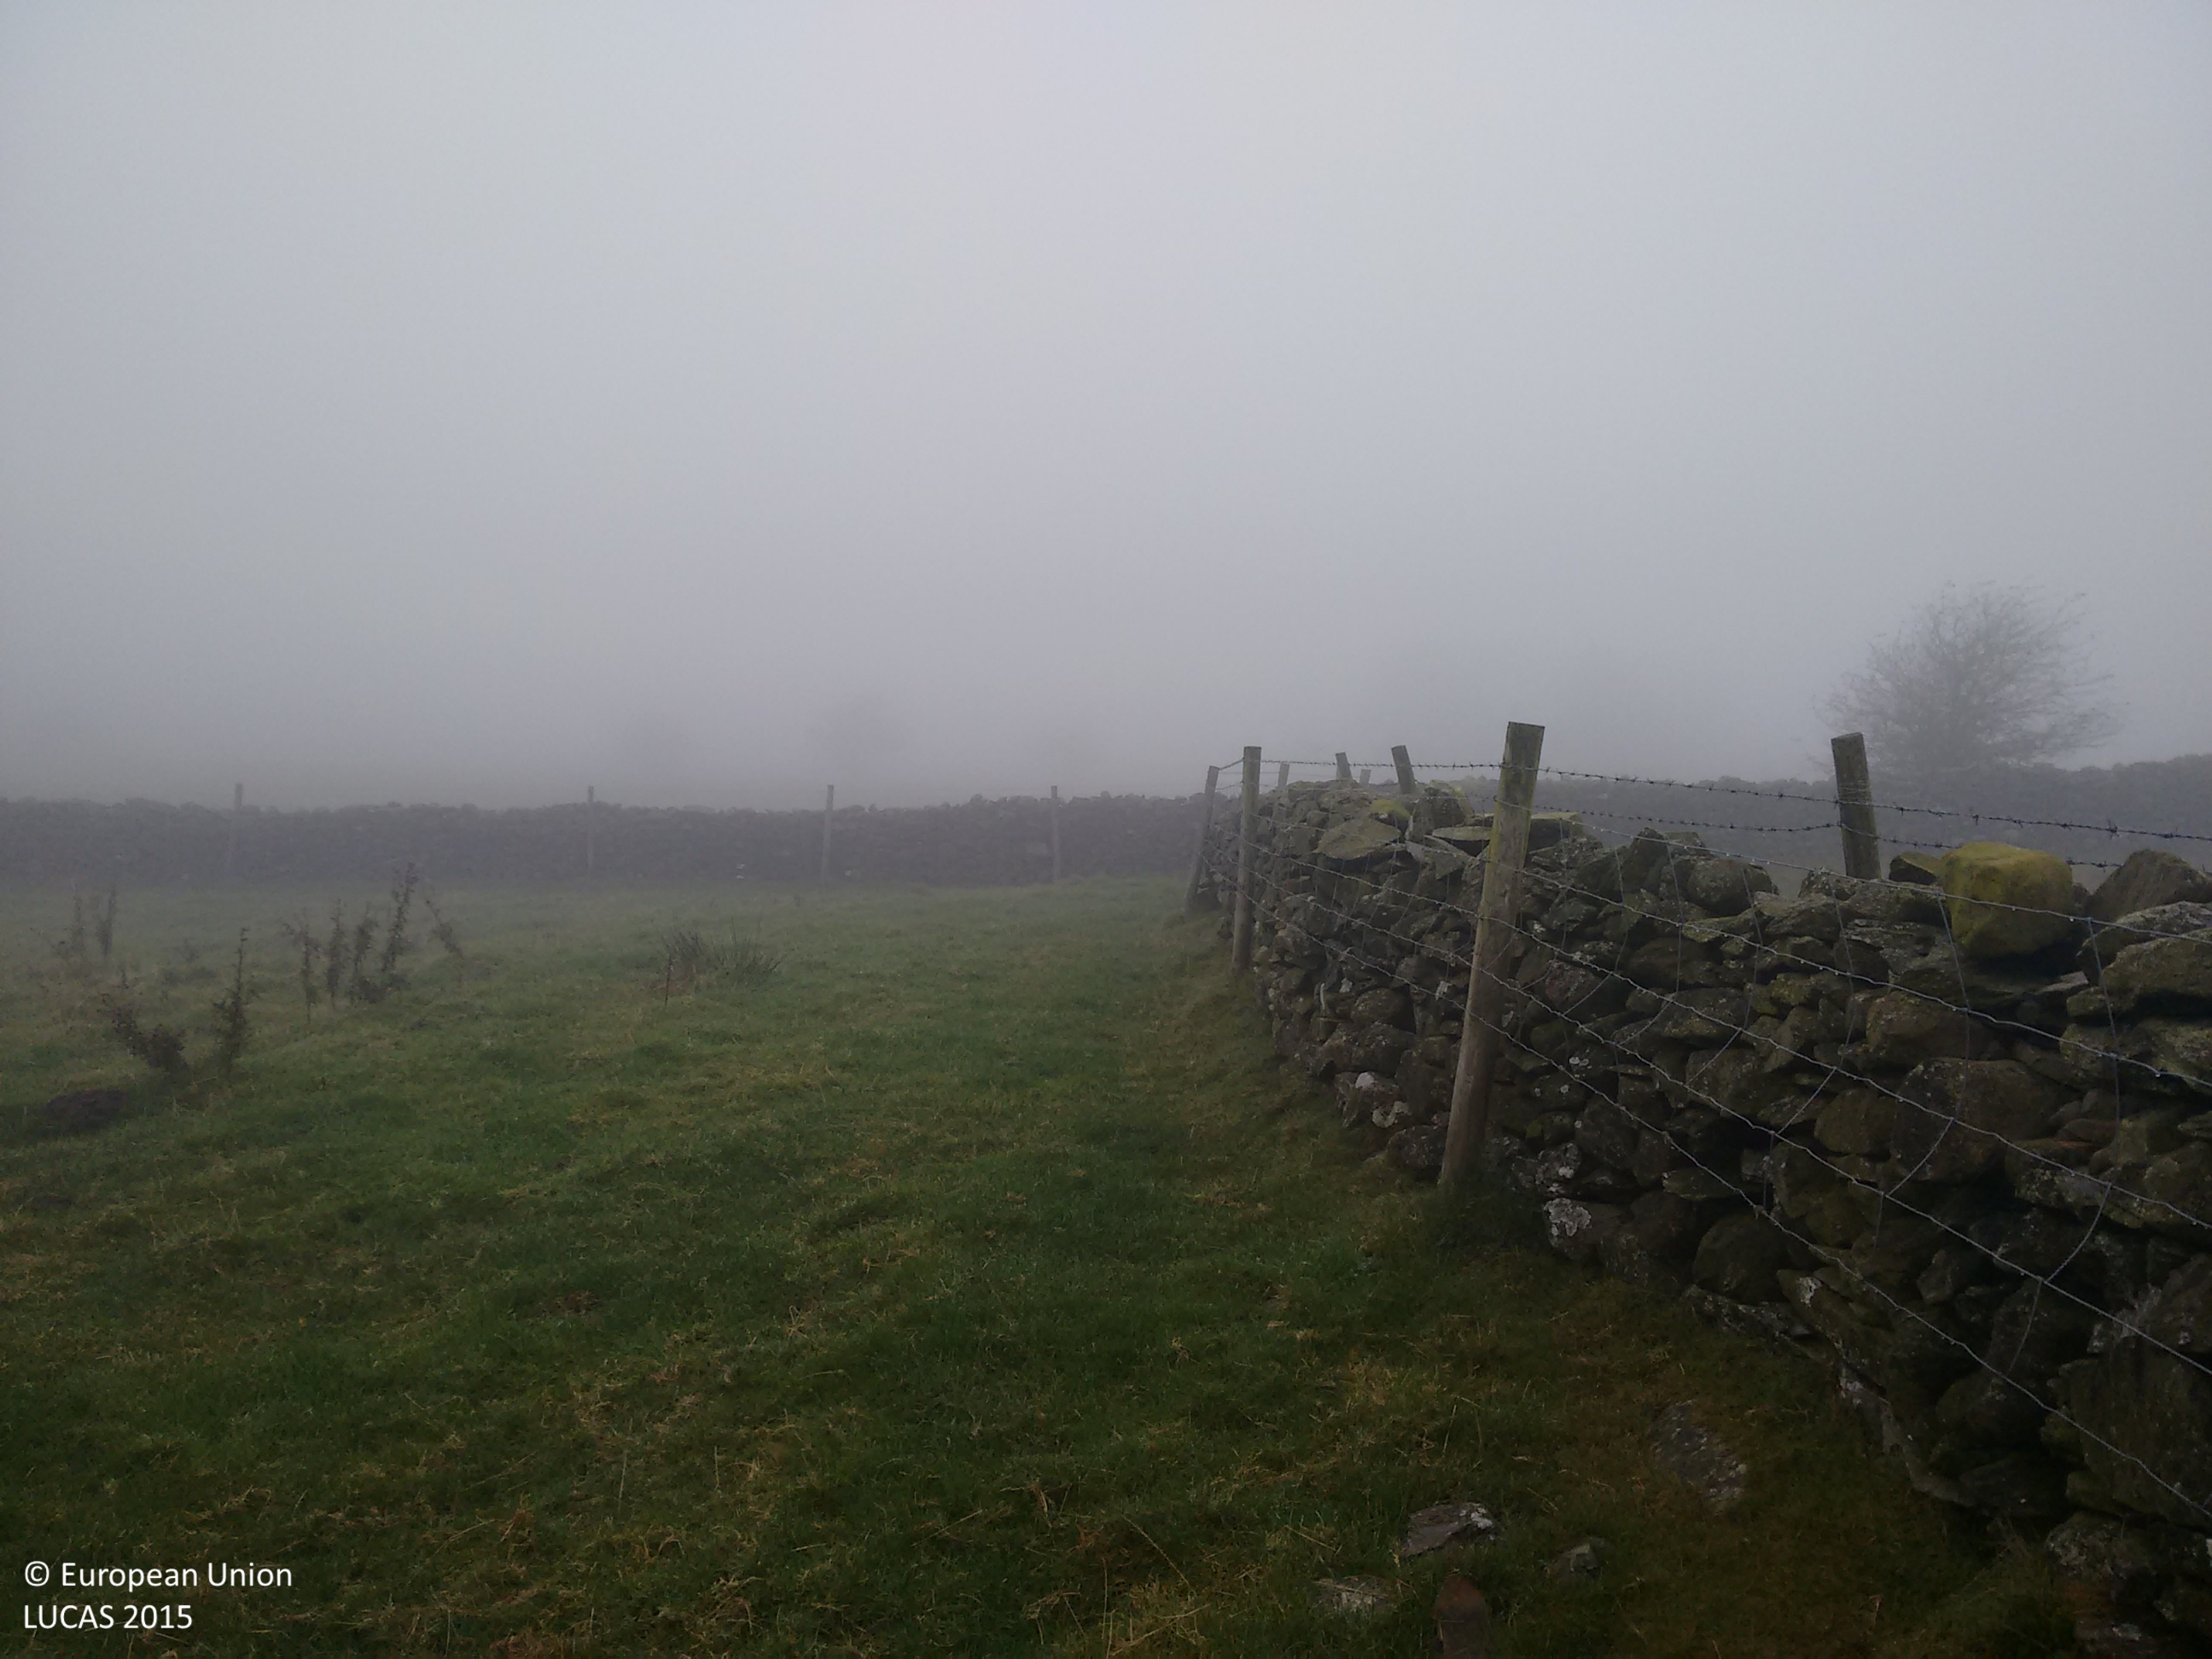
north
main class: Grassland
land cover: Grassland without tree/shrub cover
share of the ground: > 75 %
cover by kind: herbaceous plants 100 %
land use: Agriculture (excluding fallow land and kitchen gardens)
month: November
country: GB
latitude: 54.2357
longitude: -3.1006
